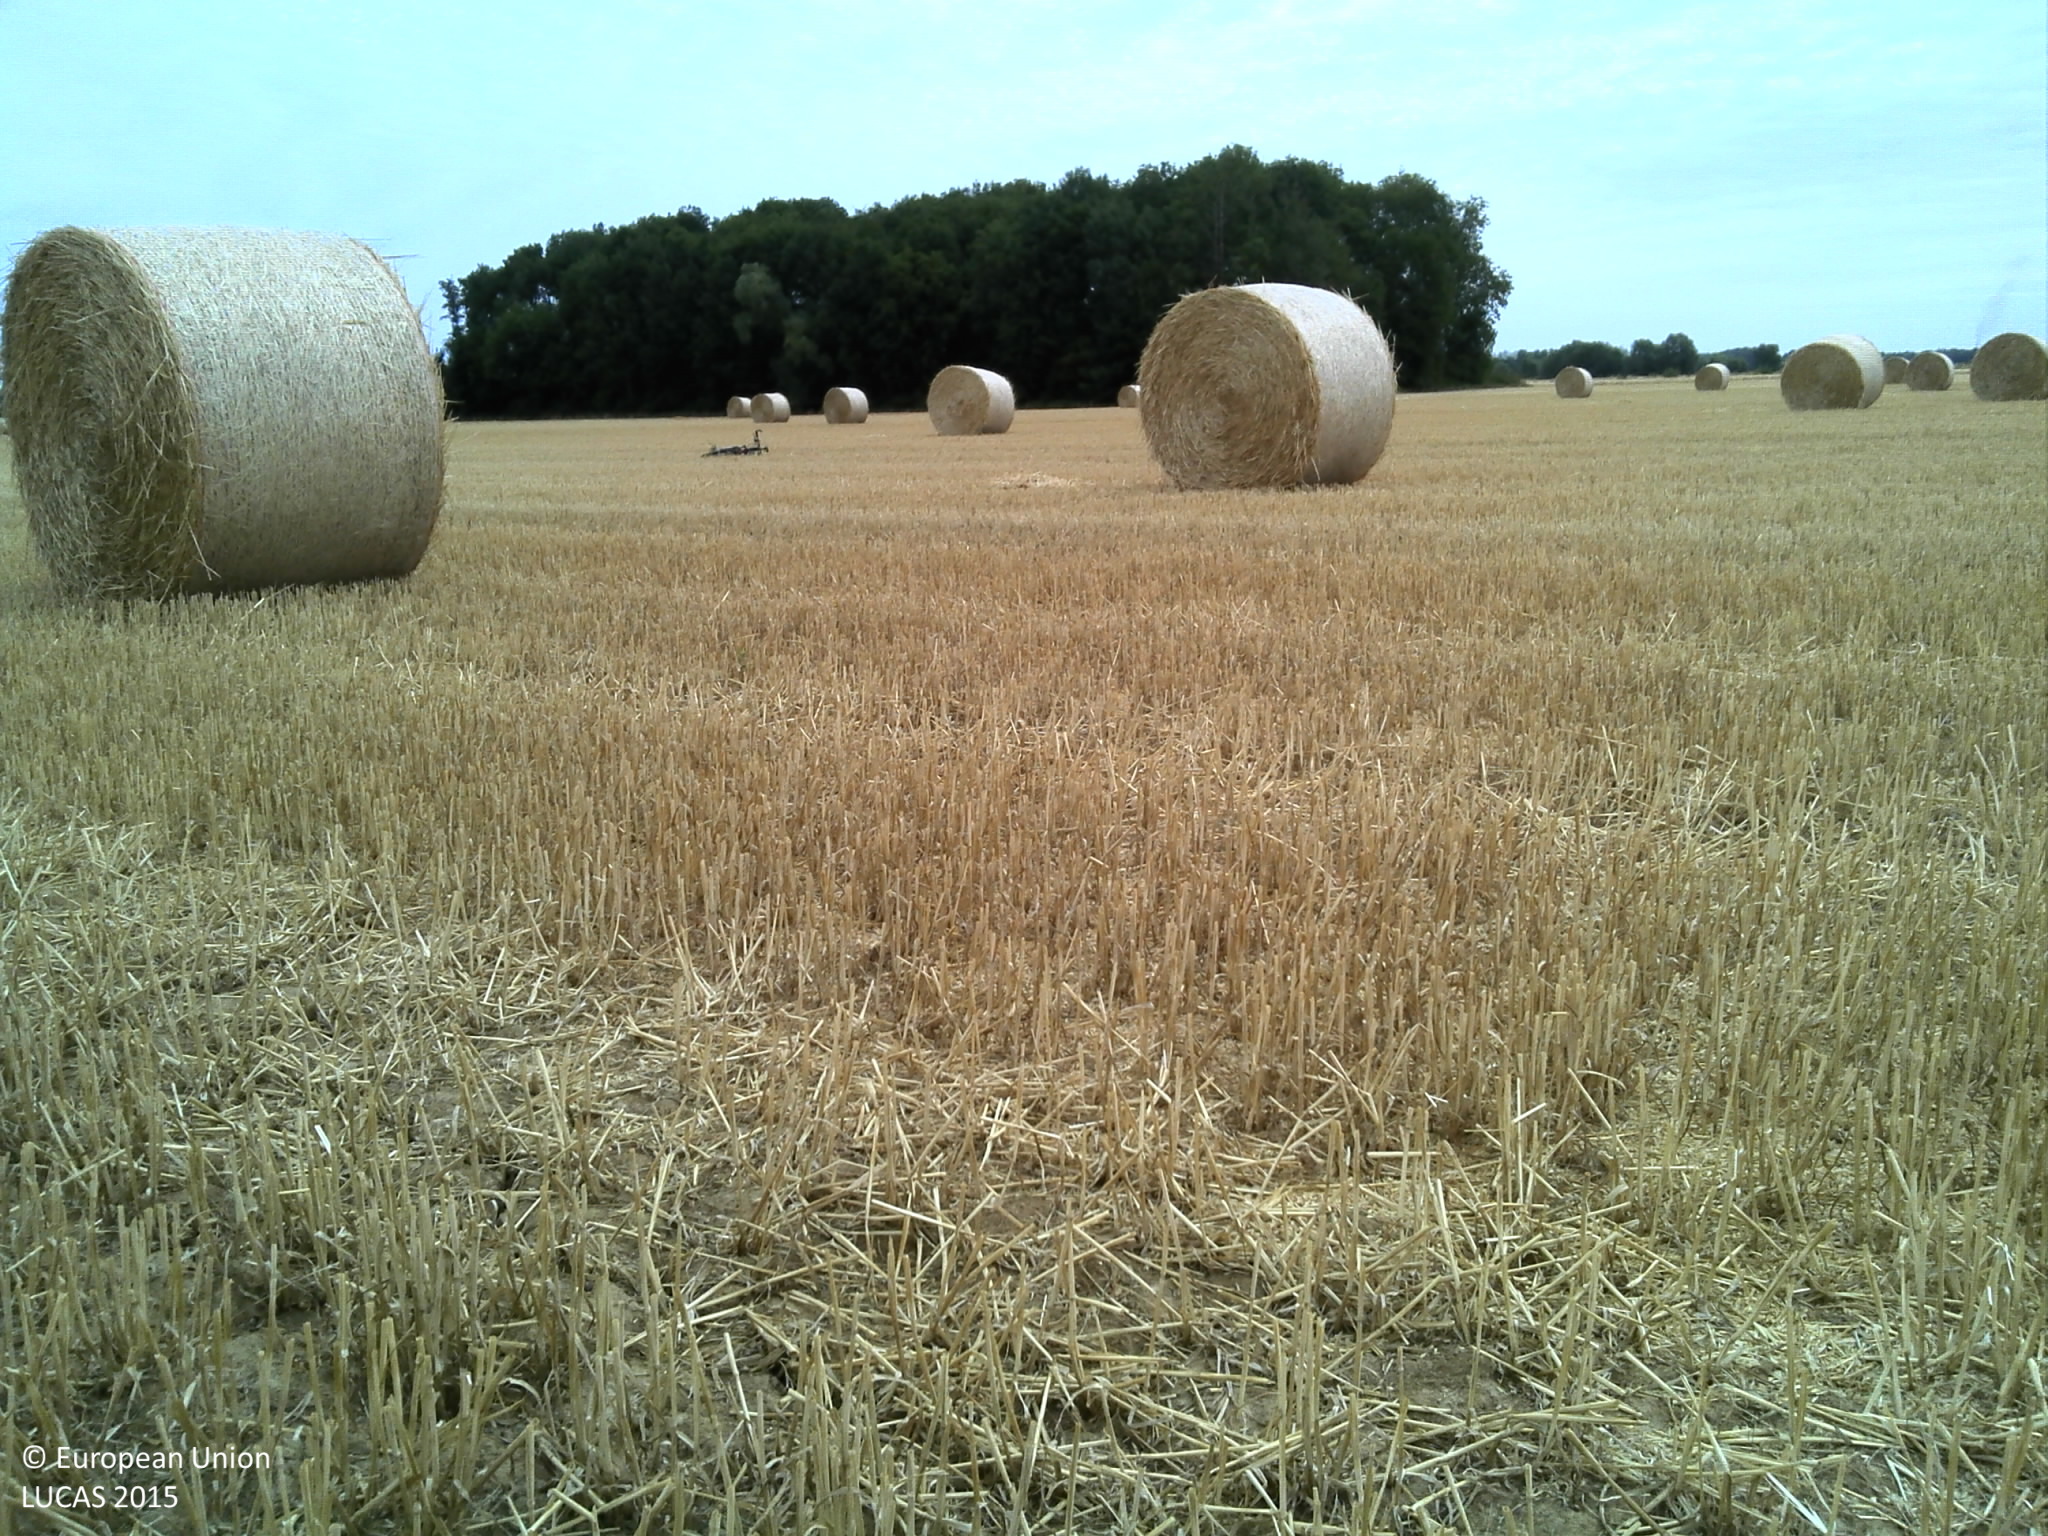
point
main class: Cropland
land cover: Common wheat
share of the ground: > 75 %
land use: Agriculture (excluding fallow land and kitchen gardens)
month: July
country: FR
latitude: 48.7263
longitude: 4.6820
